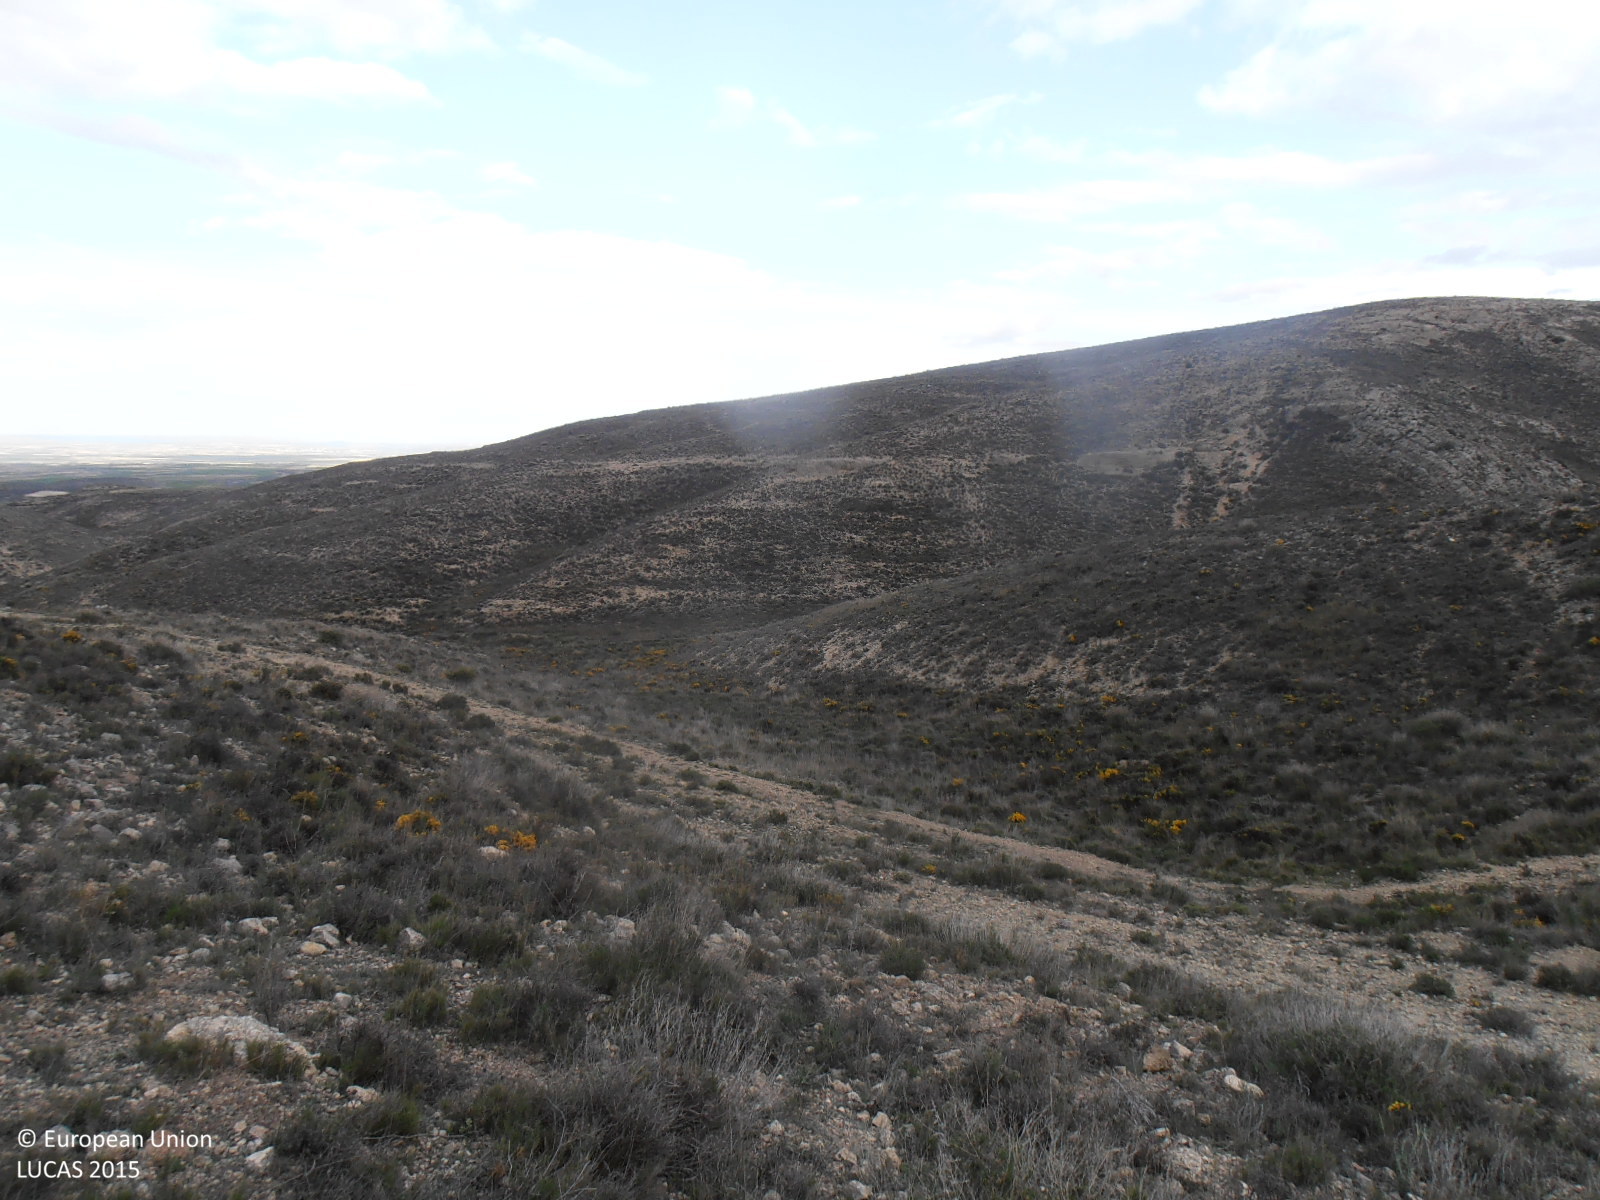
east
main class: Shrubland
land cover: Shrubland without tree cover
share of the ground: 50 - 75 %
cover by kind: shrubs 50 %, consolidated bare surface 40 %, herbaceous plants 10 %
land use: Semi-natural and natural areas not in use
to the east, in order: Shrubland without tree cover; Tracks; Shrubland without tree cover; Dry stone walls; Shrubland without tree cover
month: April
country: ES
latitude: 41.1563
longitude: -0.7052
